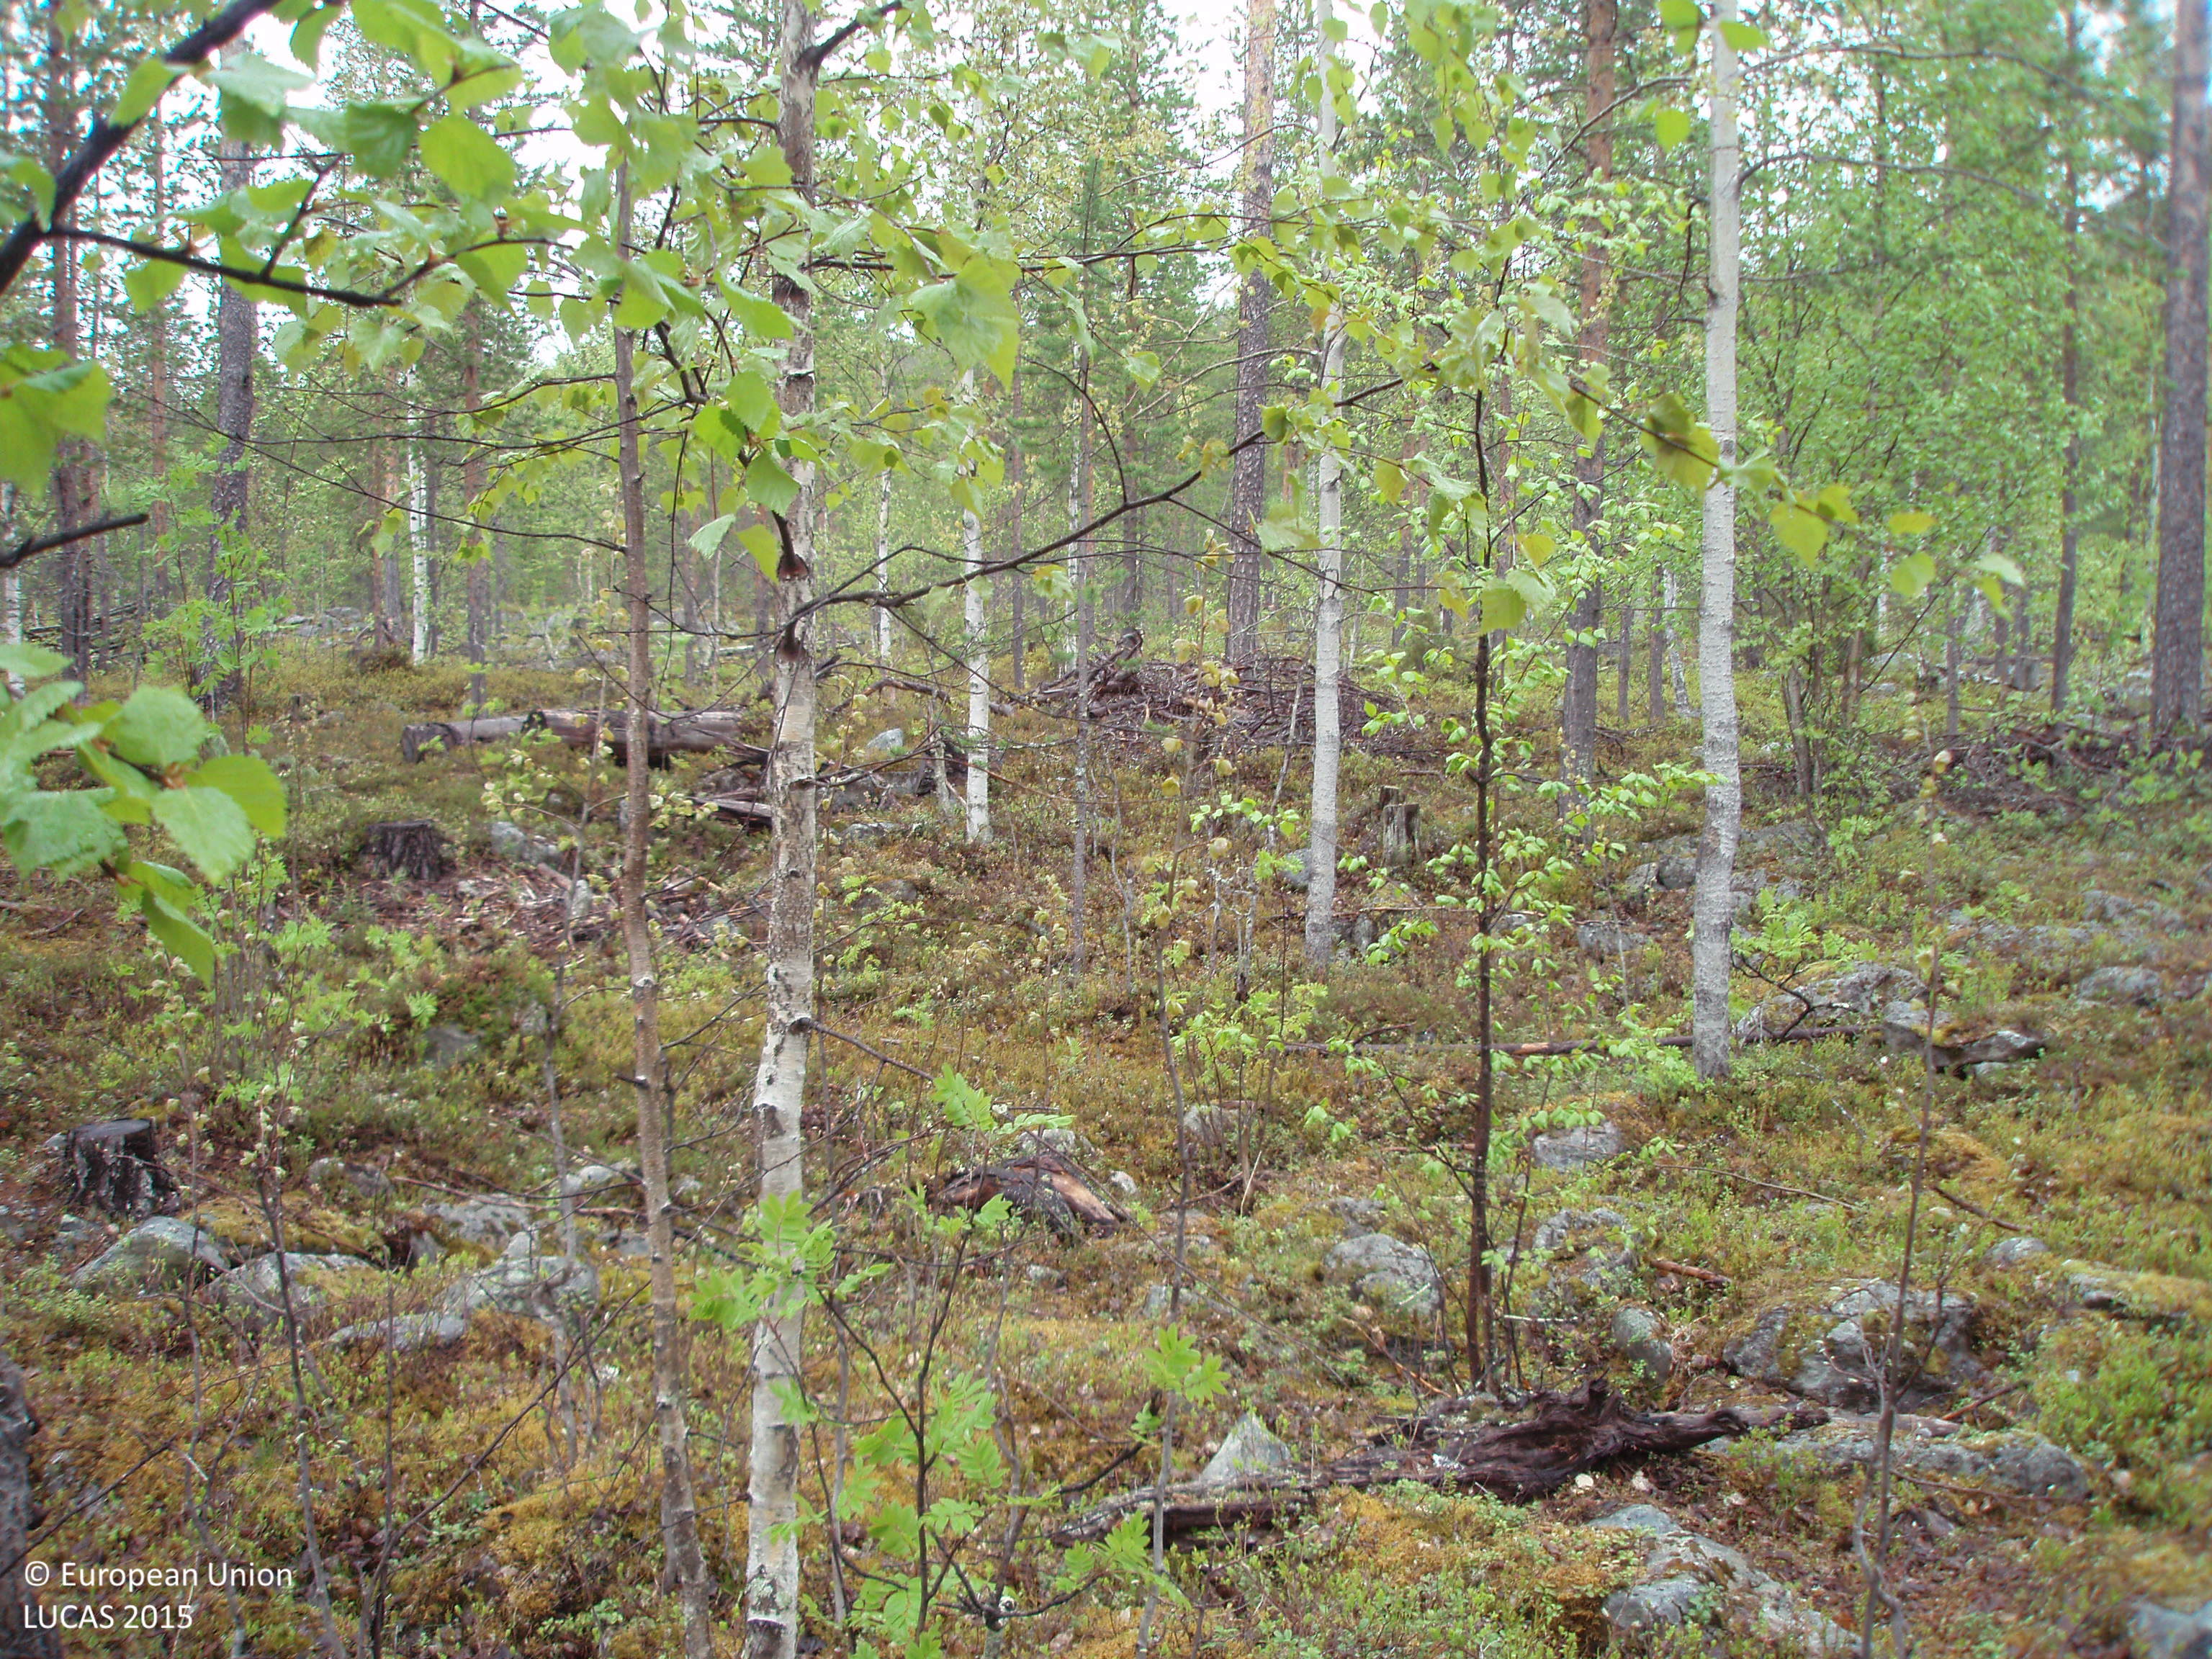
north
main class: Woodland
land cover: Pine dominated mixed woodland
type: boreal forest
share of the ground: 50 - 75 %
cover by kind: coniferous forest trees 35 %, shrubs 35 %, broadleaved forest trees 30 %
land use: Forestry
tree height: > 5 m
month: June
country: FI
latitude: 67.6081
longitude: 26.3682
